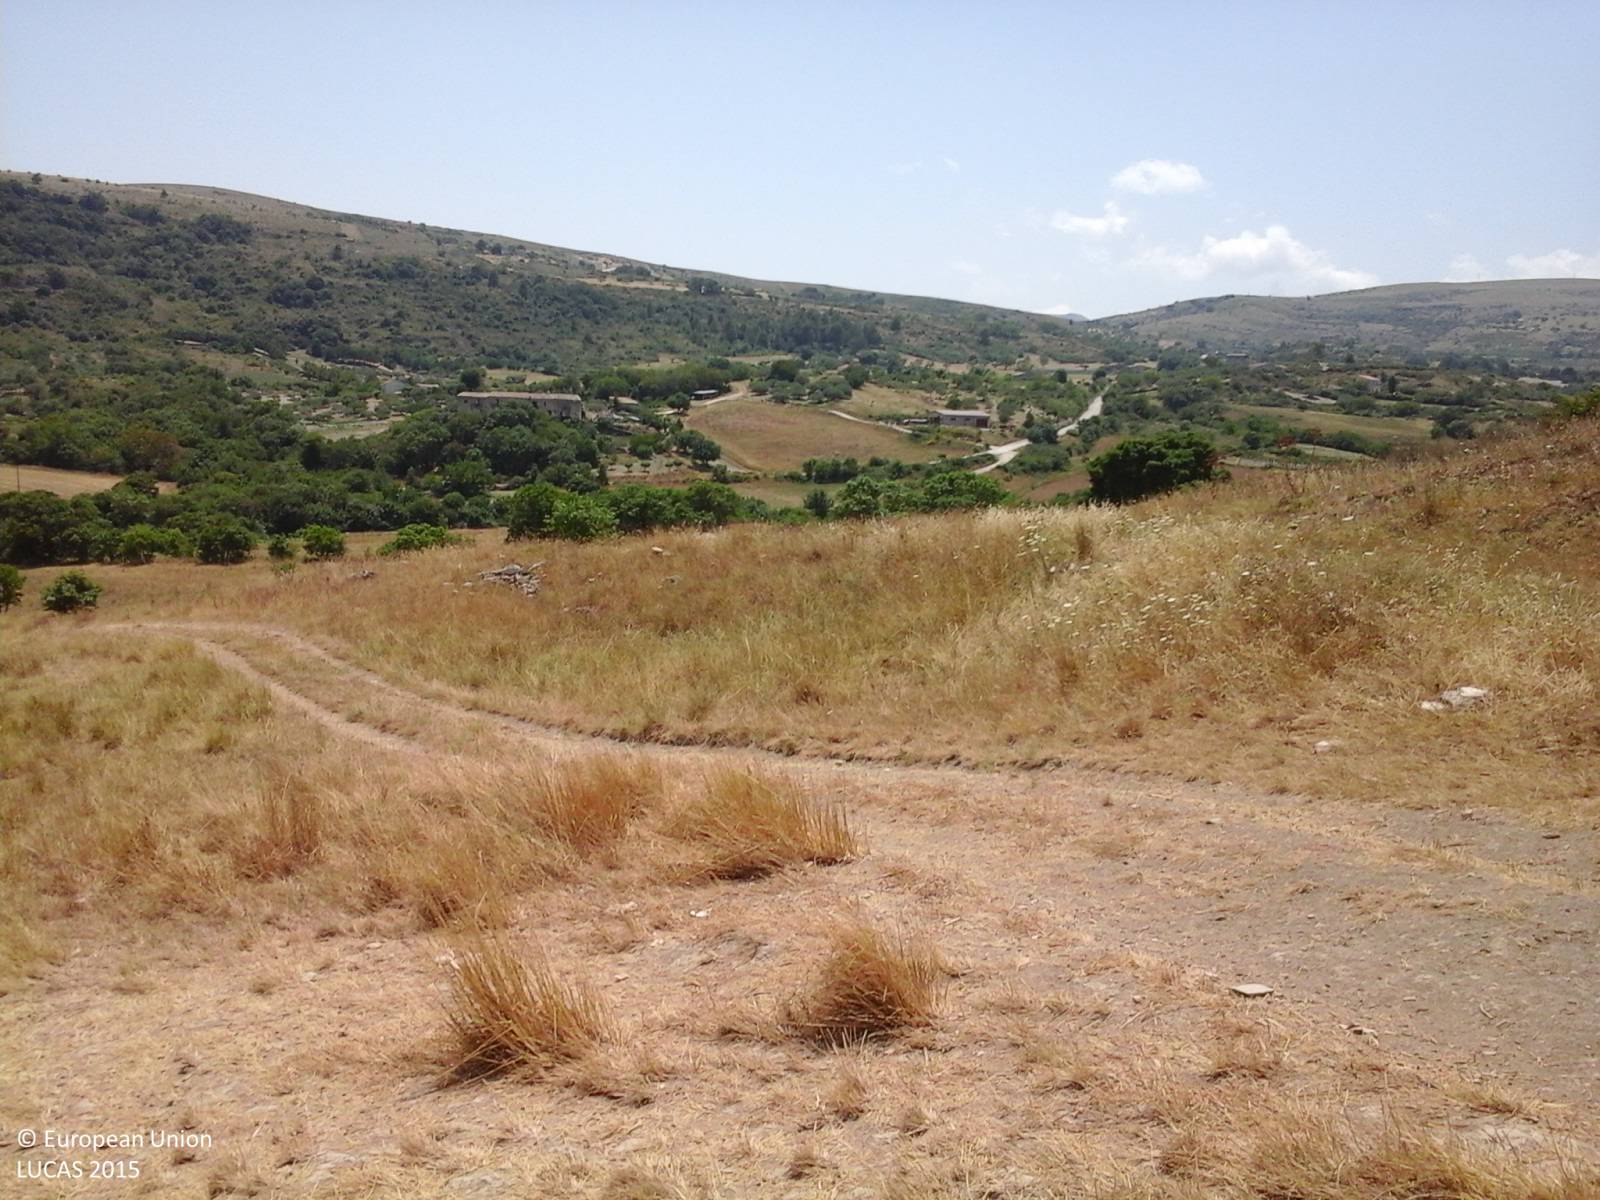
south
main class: Grassland
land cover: Grassland without tree/shrub cover
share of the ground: > 75 %
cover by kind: herbaceous plants 100 %
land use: Abandoned areas
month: July
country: IT
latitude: 37.7202
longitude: 13.4799
